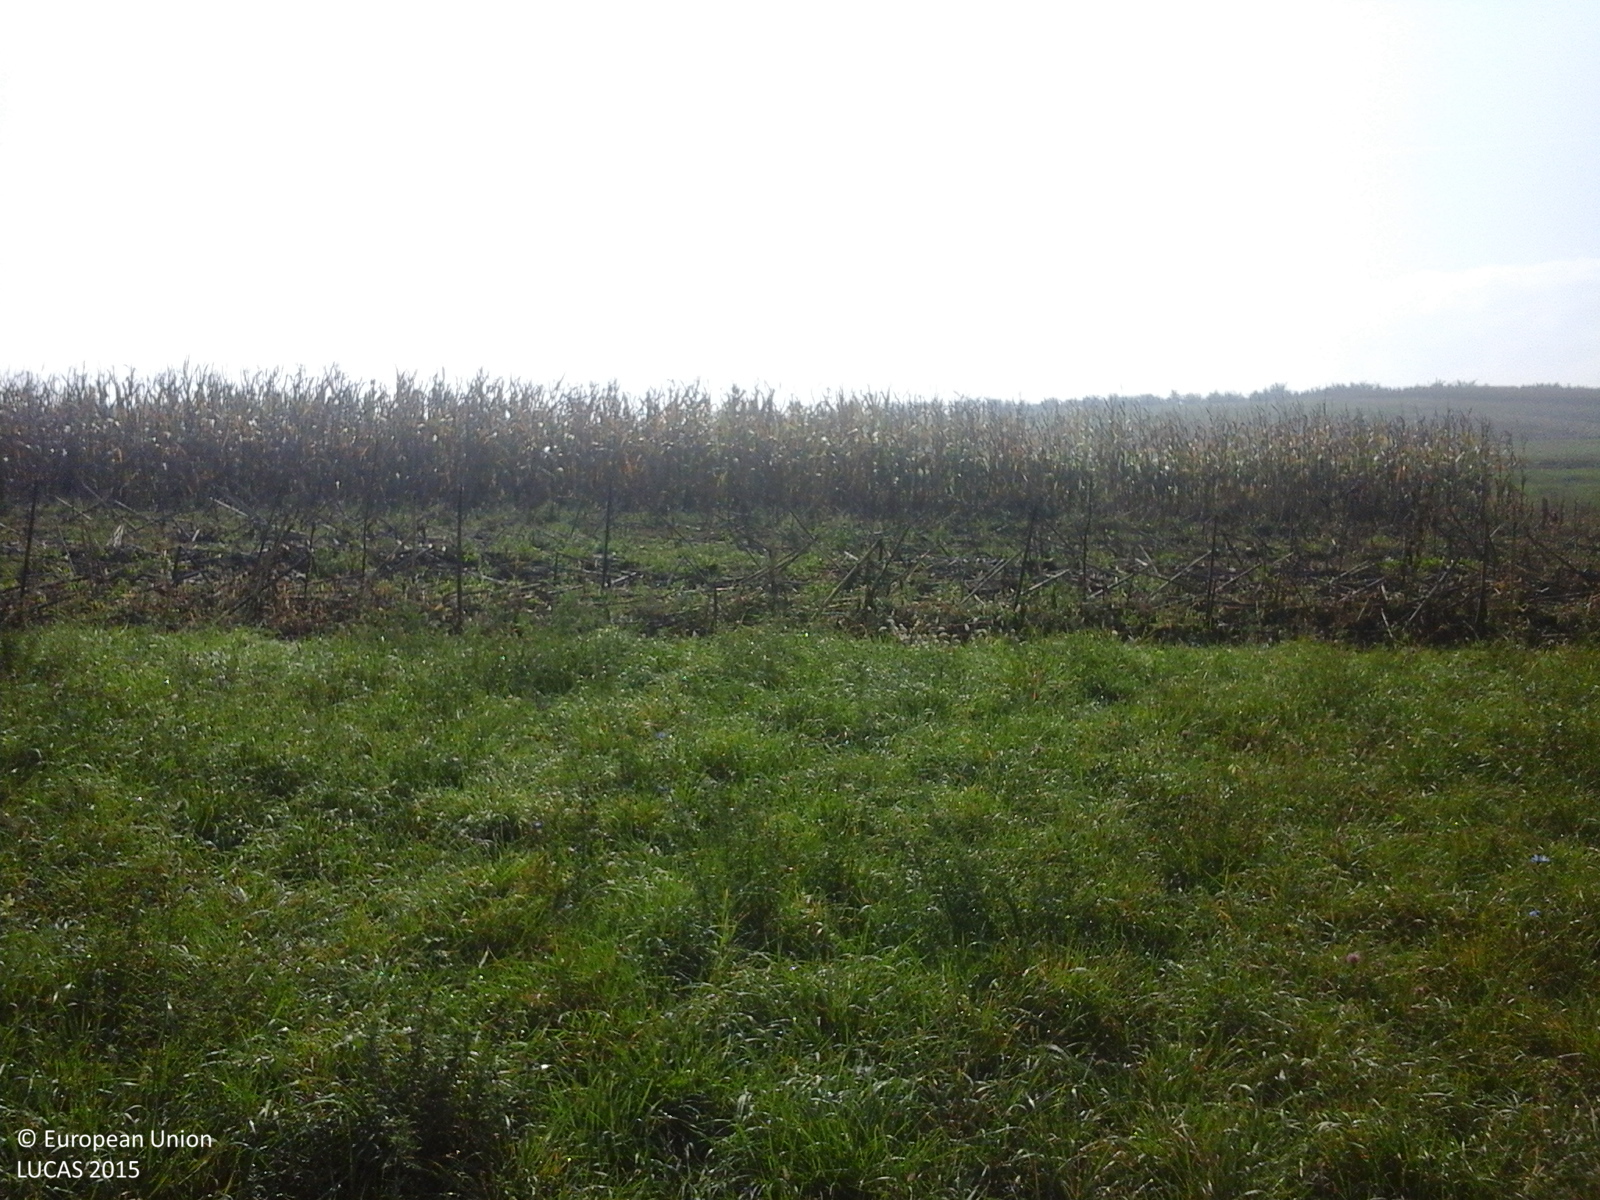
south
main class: Cropland
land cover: Other leguminous and mixtures for fodder
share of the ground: > 75 %
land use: Agriculture (excluding fallow land and kitchen gardens)
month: October
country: RO
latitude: 46.5631
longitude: 24.3692
